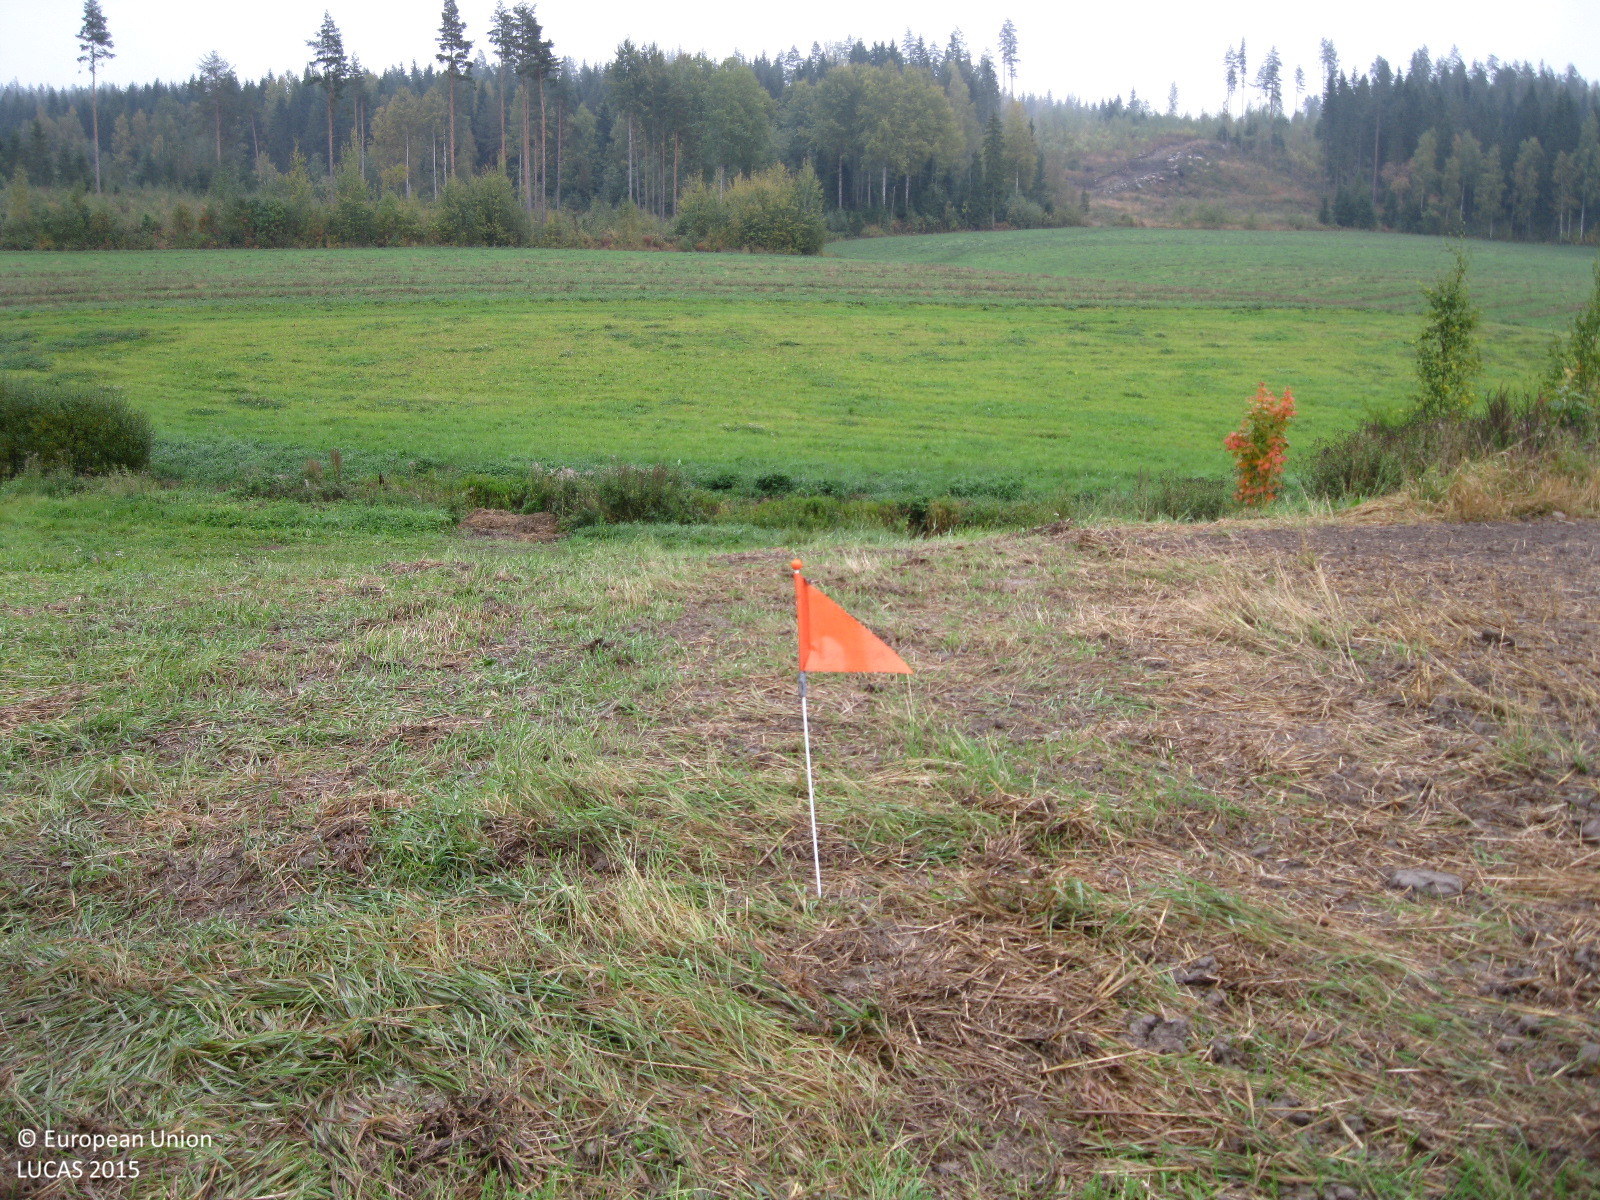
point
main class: Cropland
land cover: Temporary grasslands
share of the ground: > 75 %
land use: Agriculture (excluding fallow land and kitchen gardens)
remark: Harvested field
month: September
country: FI
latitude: 60.9087
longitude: 25.0690
